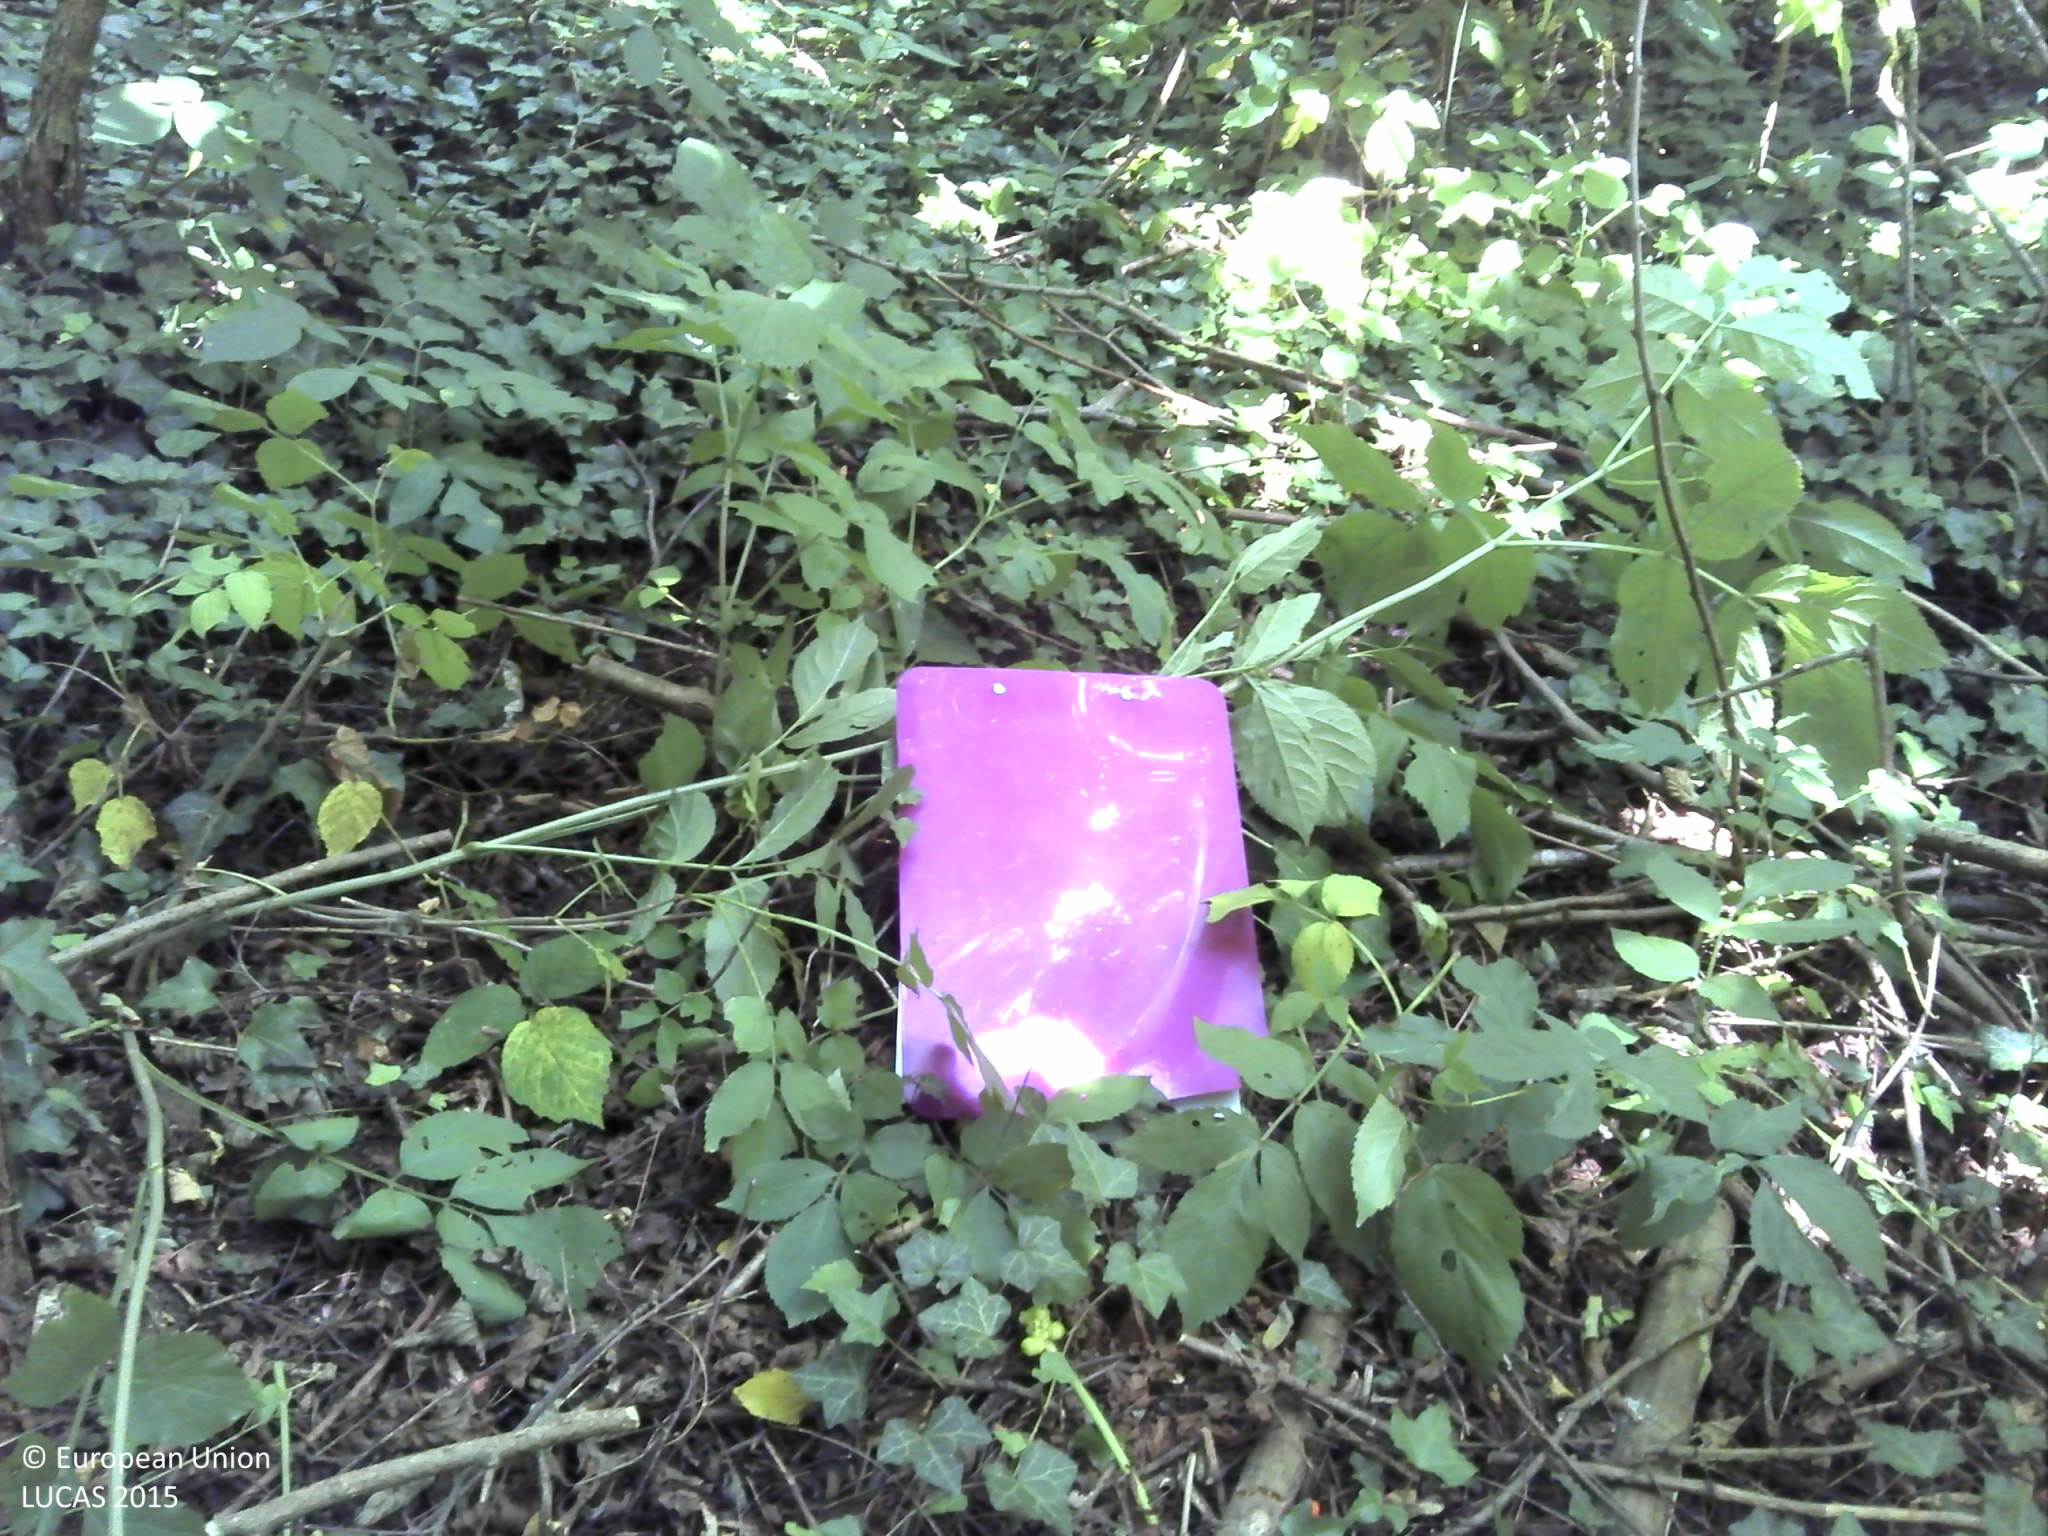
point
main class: Shrubland
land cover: Shrubland with sparse tree cover
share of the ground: > 75 %
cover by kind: shrubs 95 %, broadleaved forest trees 5 %
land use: Semi-natural and natural areas not in use
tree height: < 5 m
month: July
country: HR
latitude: 45.5350
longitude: 16.8503
